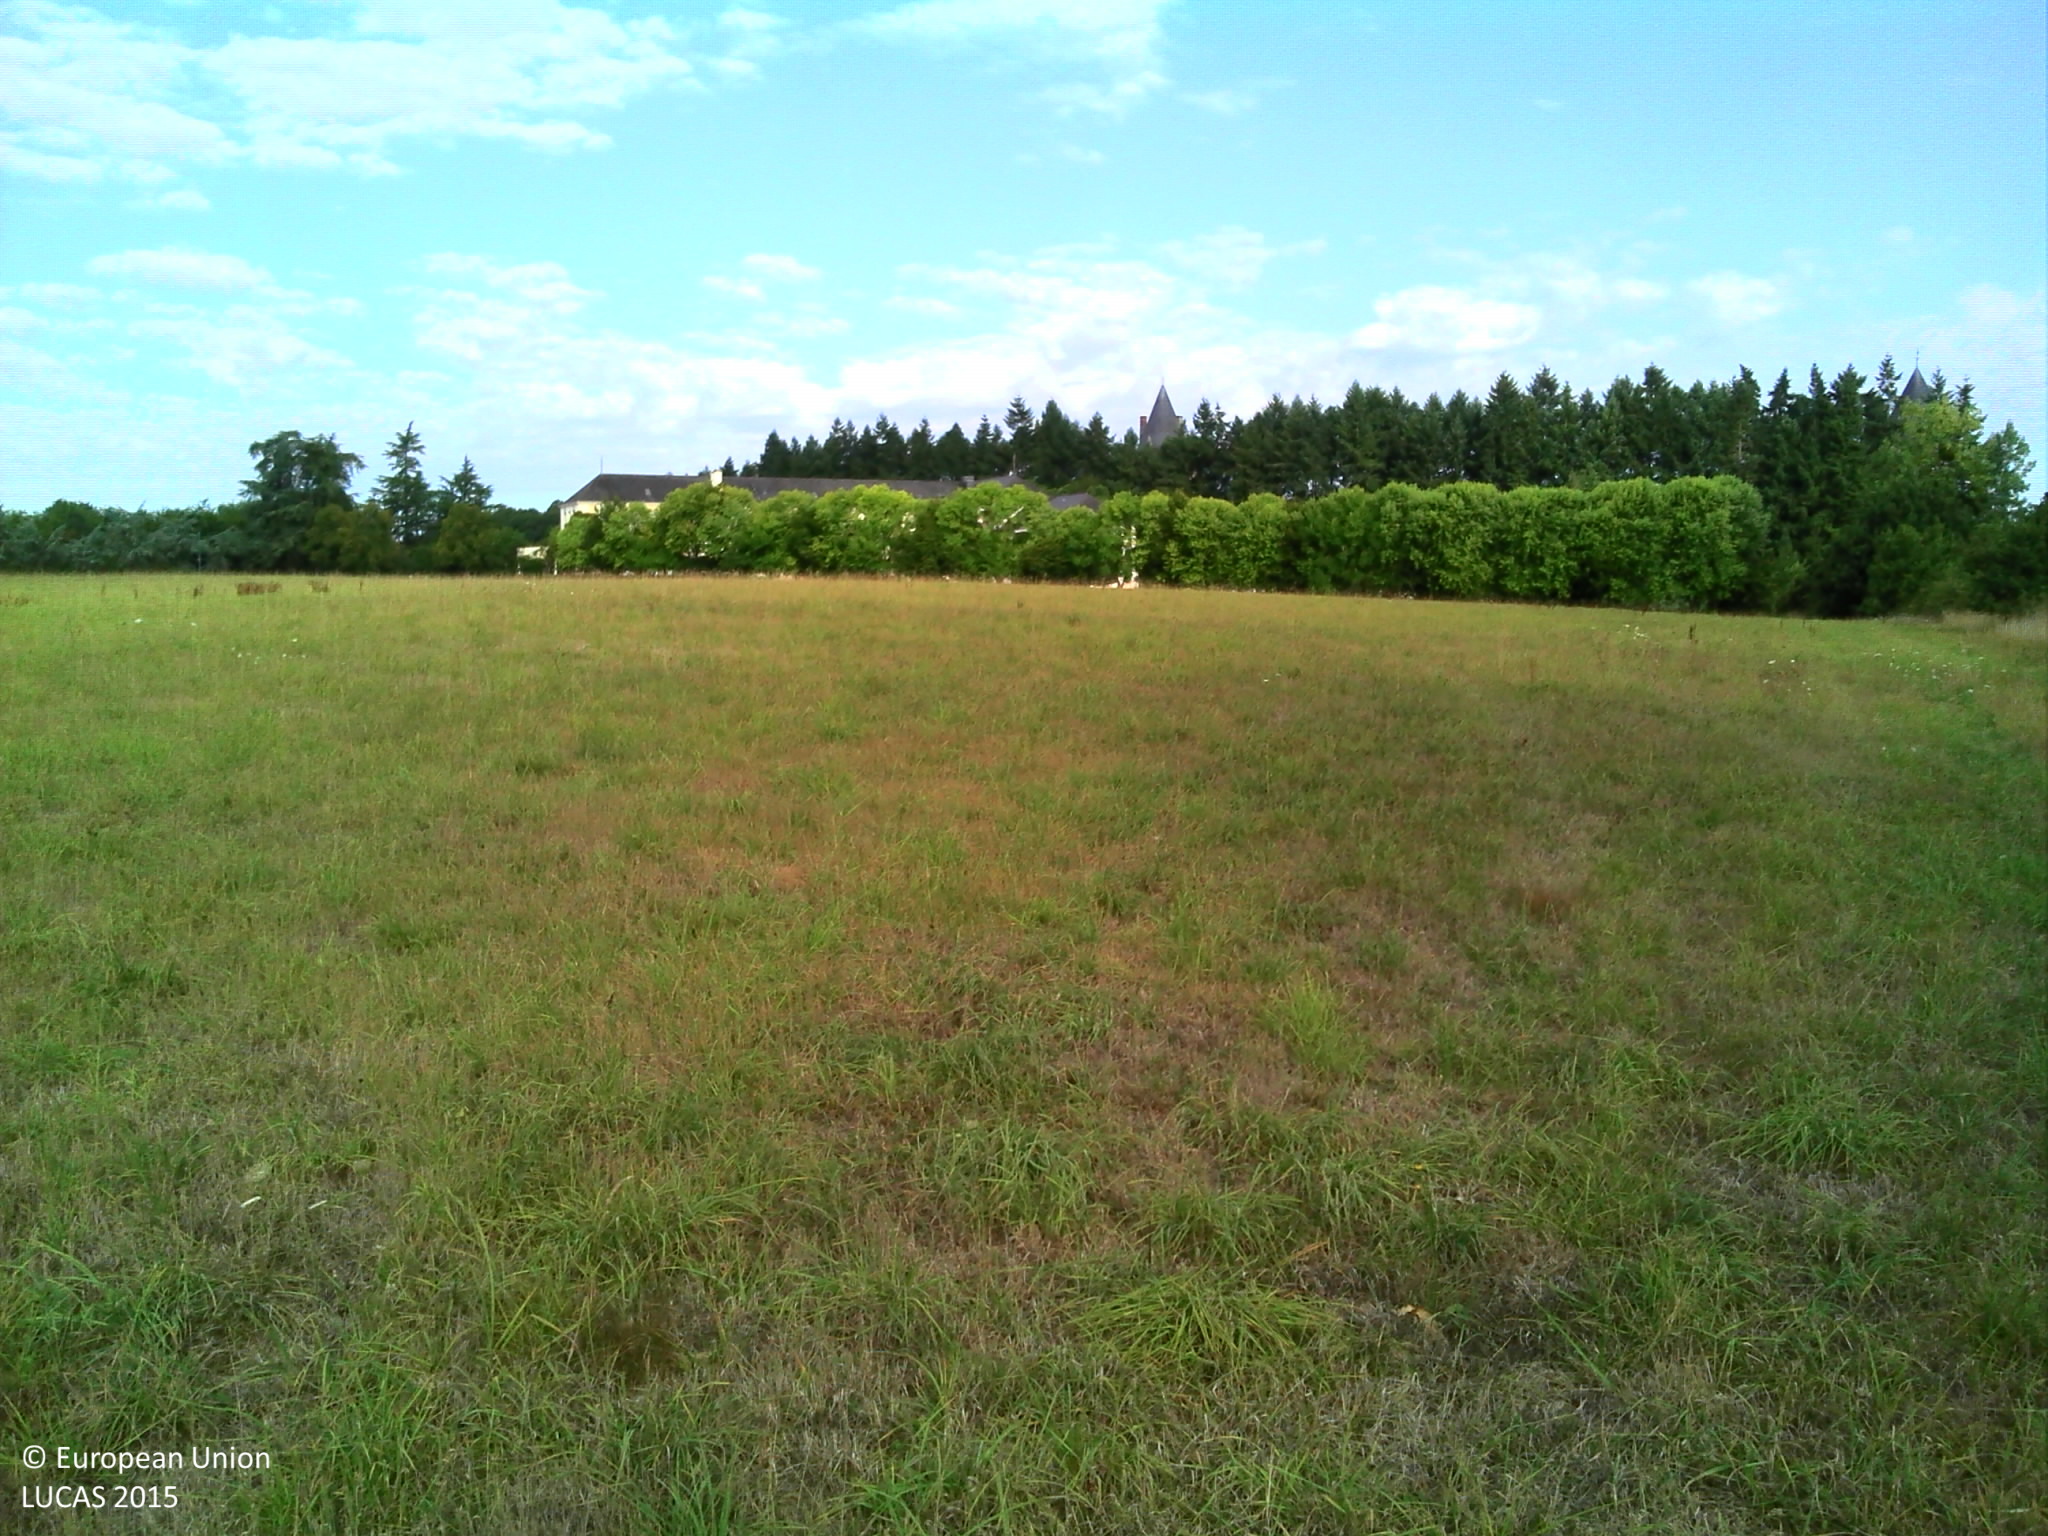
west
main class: Cropland
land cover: Temporary grasslands
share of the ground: > 75 %
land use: Agriculture (excluding fallow land and kitchen gardens)
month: August
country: FR
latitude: 47.4643
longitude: -1.7602
